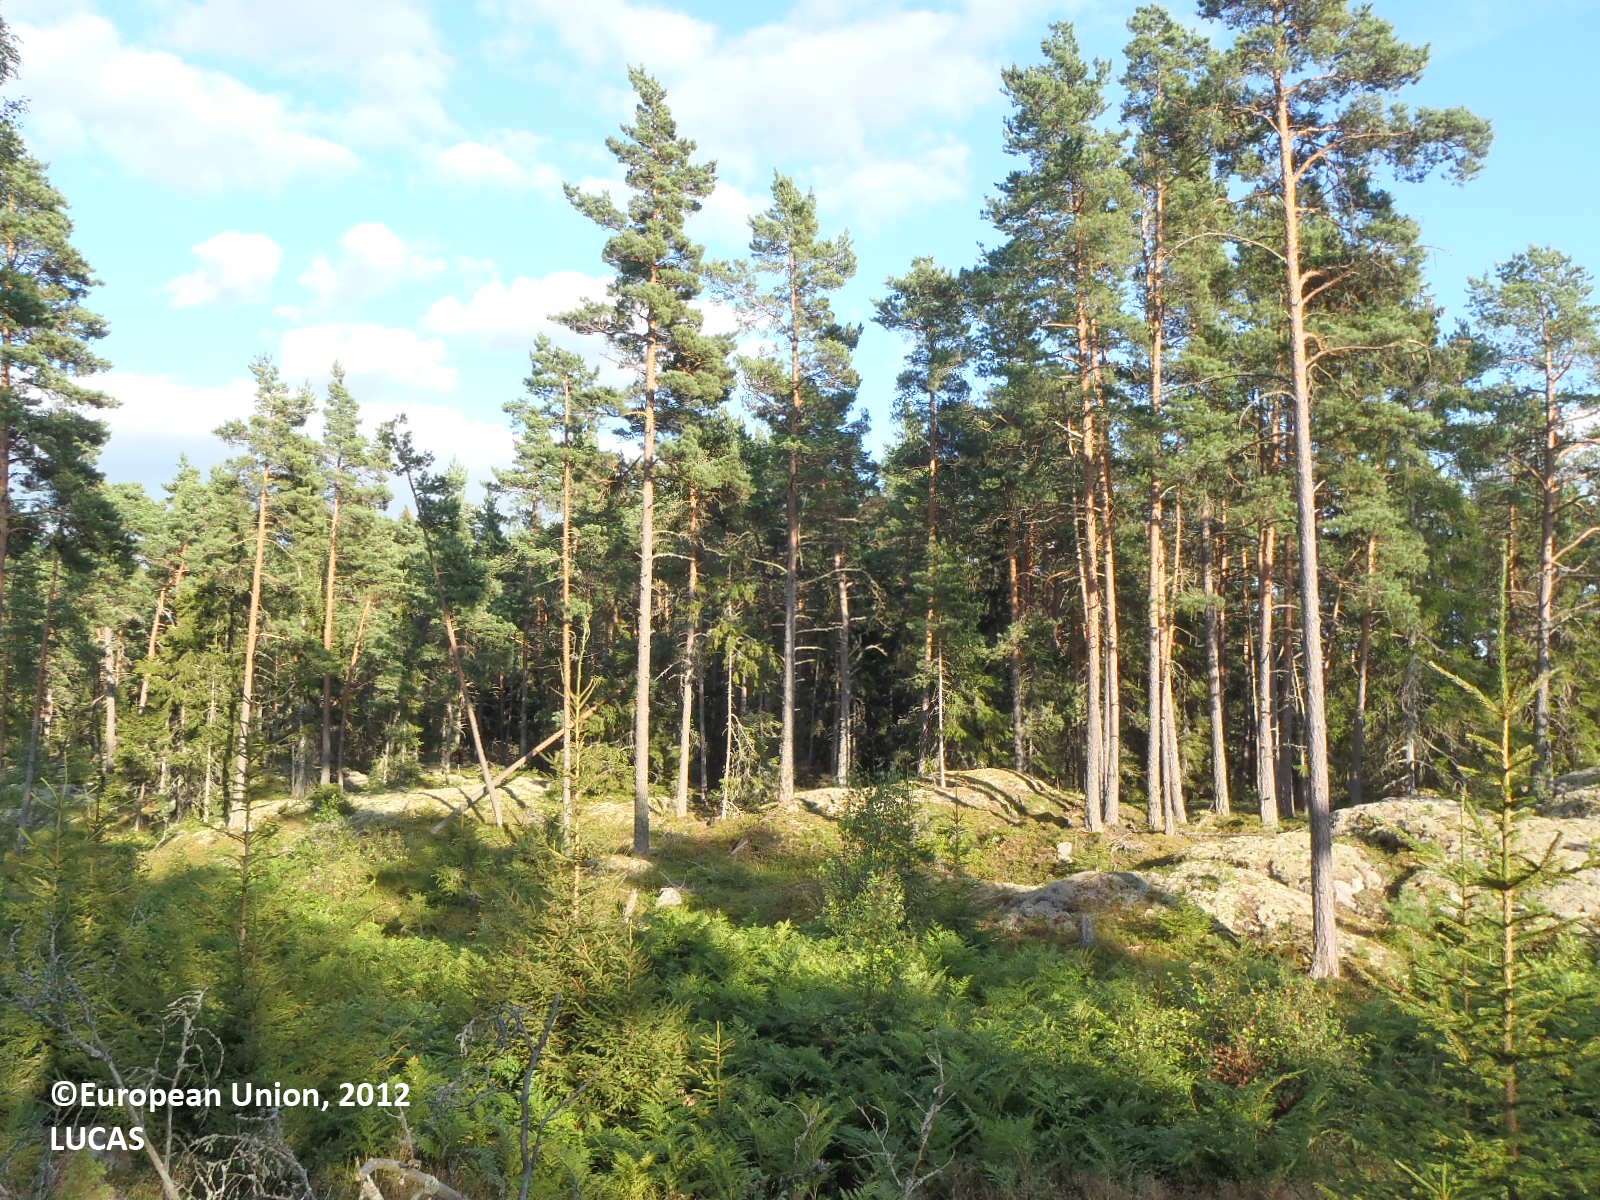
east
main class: Woodland
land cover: Pine dominated mixed woodland
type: boreal forest
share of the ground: 10 - 25 %
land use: Forestry
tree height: > 5 m
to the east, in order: Pine dominated mixed woodland; Pine dominated coniferous woodland; Spruce dominated mixed woodland; Pine dominated coniferous woodland; Pine dominated mixed woodland
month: August
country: FI
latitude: 60.1257
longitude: 21.5242
